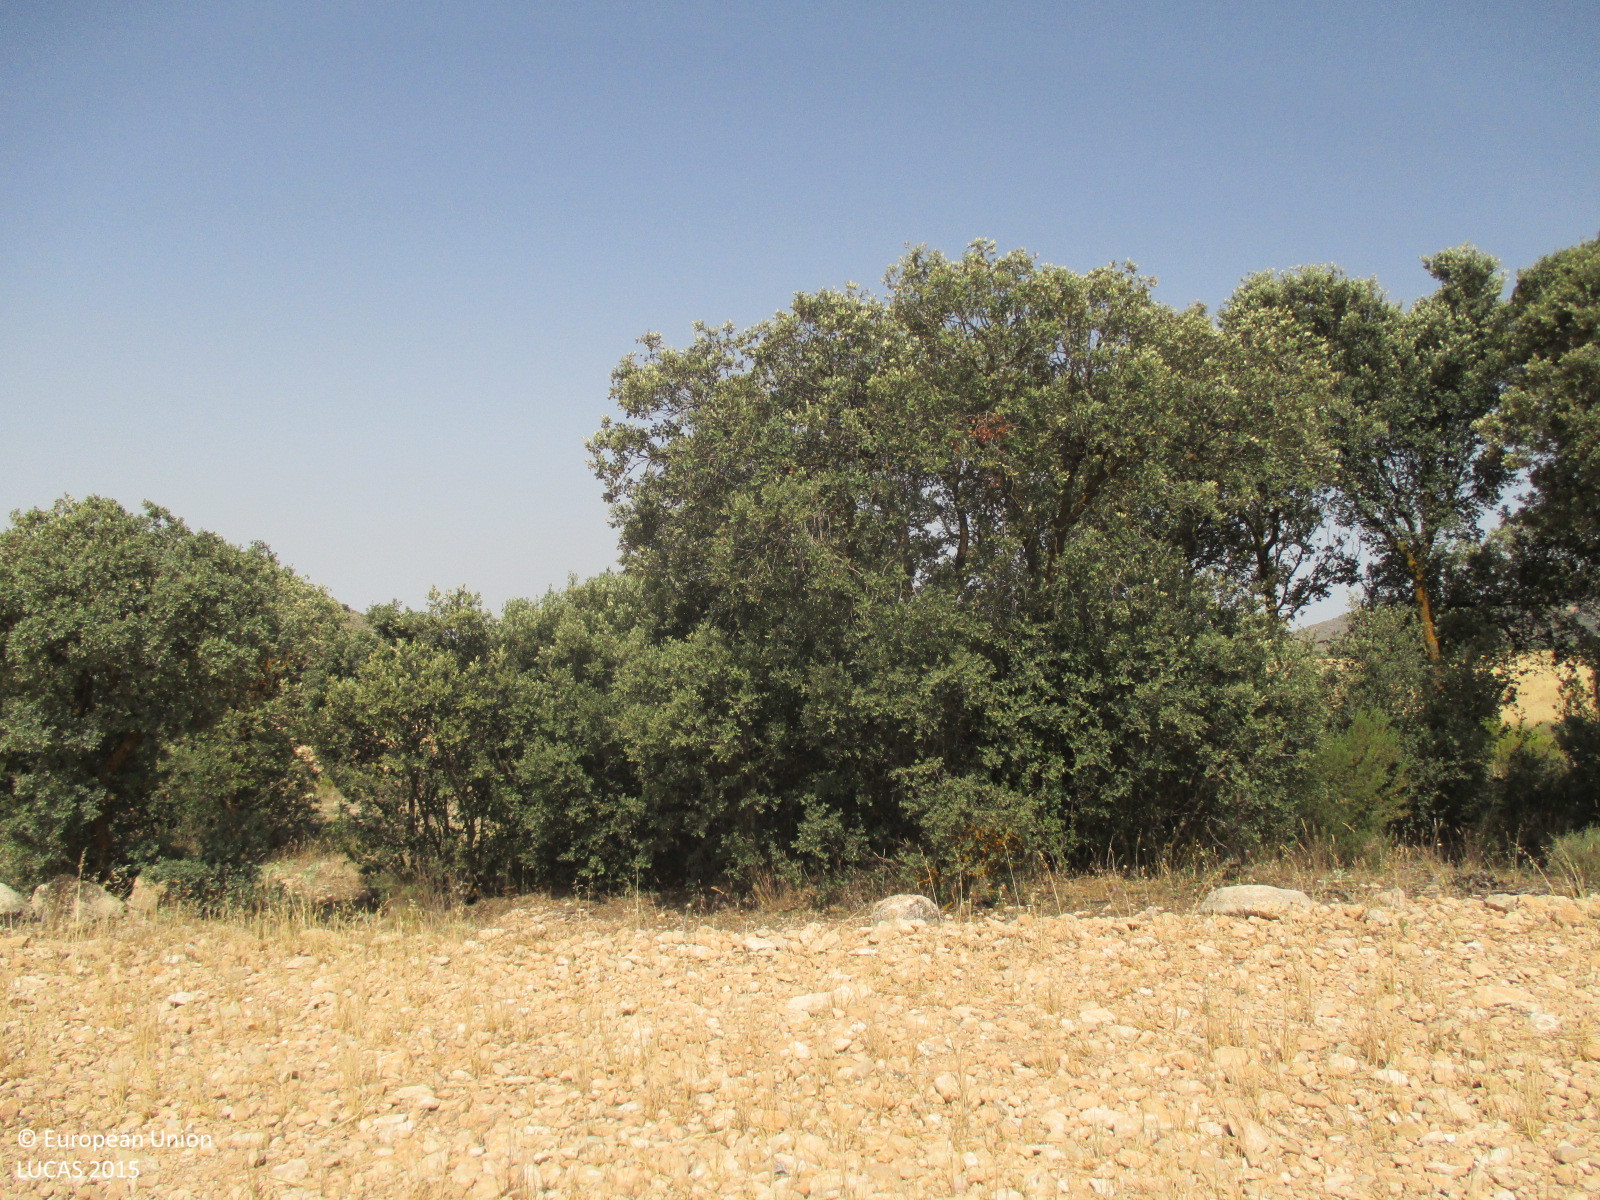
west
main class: Cropland
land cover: Oats
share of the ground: < 10 %
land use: Agriculture (excluding fallow land and kitchen gardens)
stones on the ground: < 10 %
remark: Harvested field
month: June
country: ES
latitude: 37.6059
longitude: -2.4352
